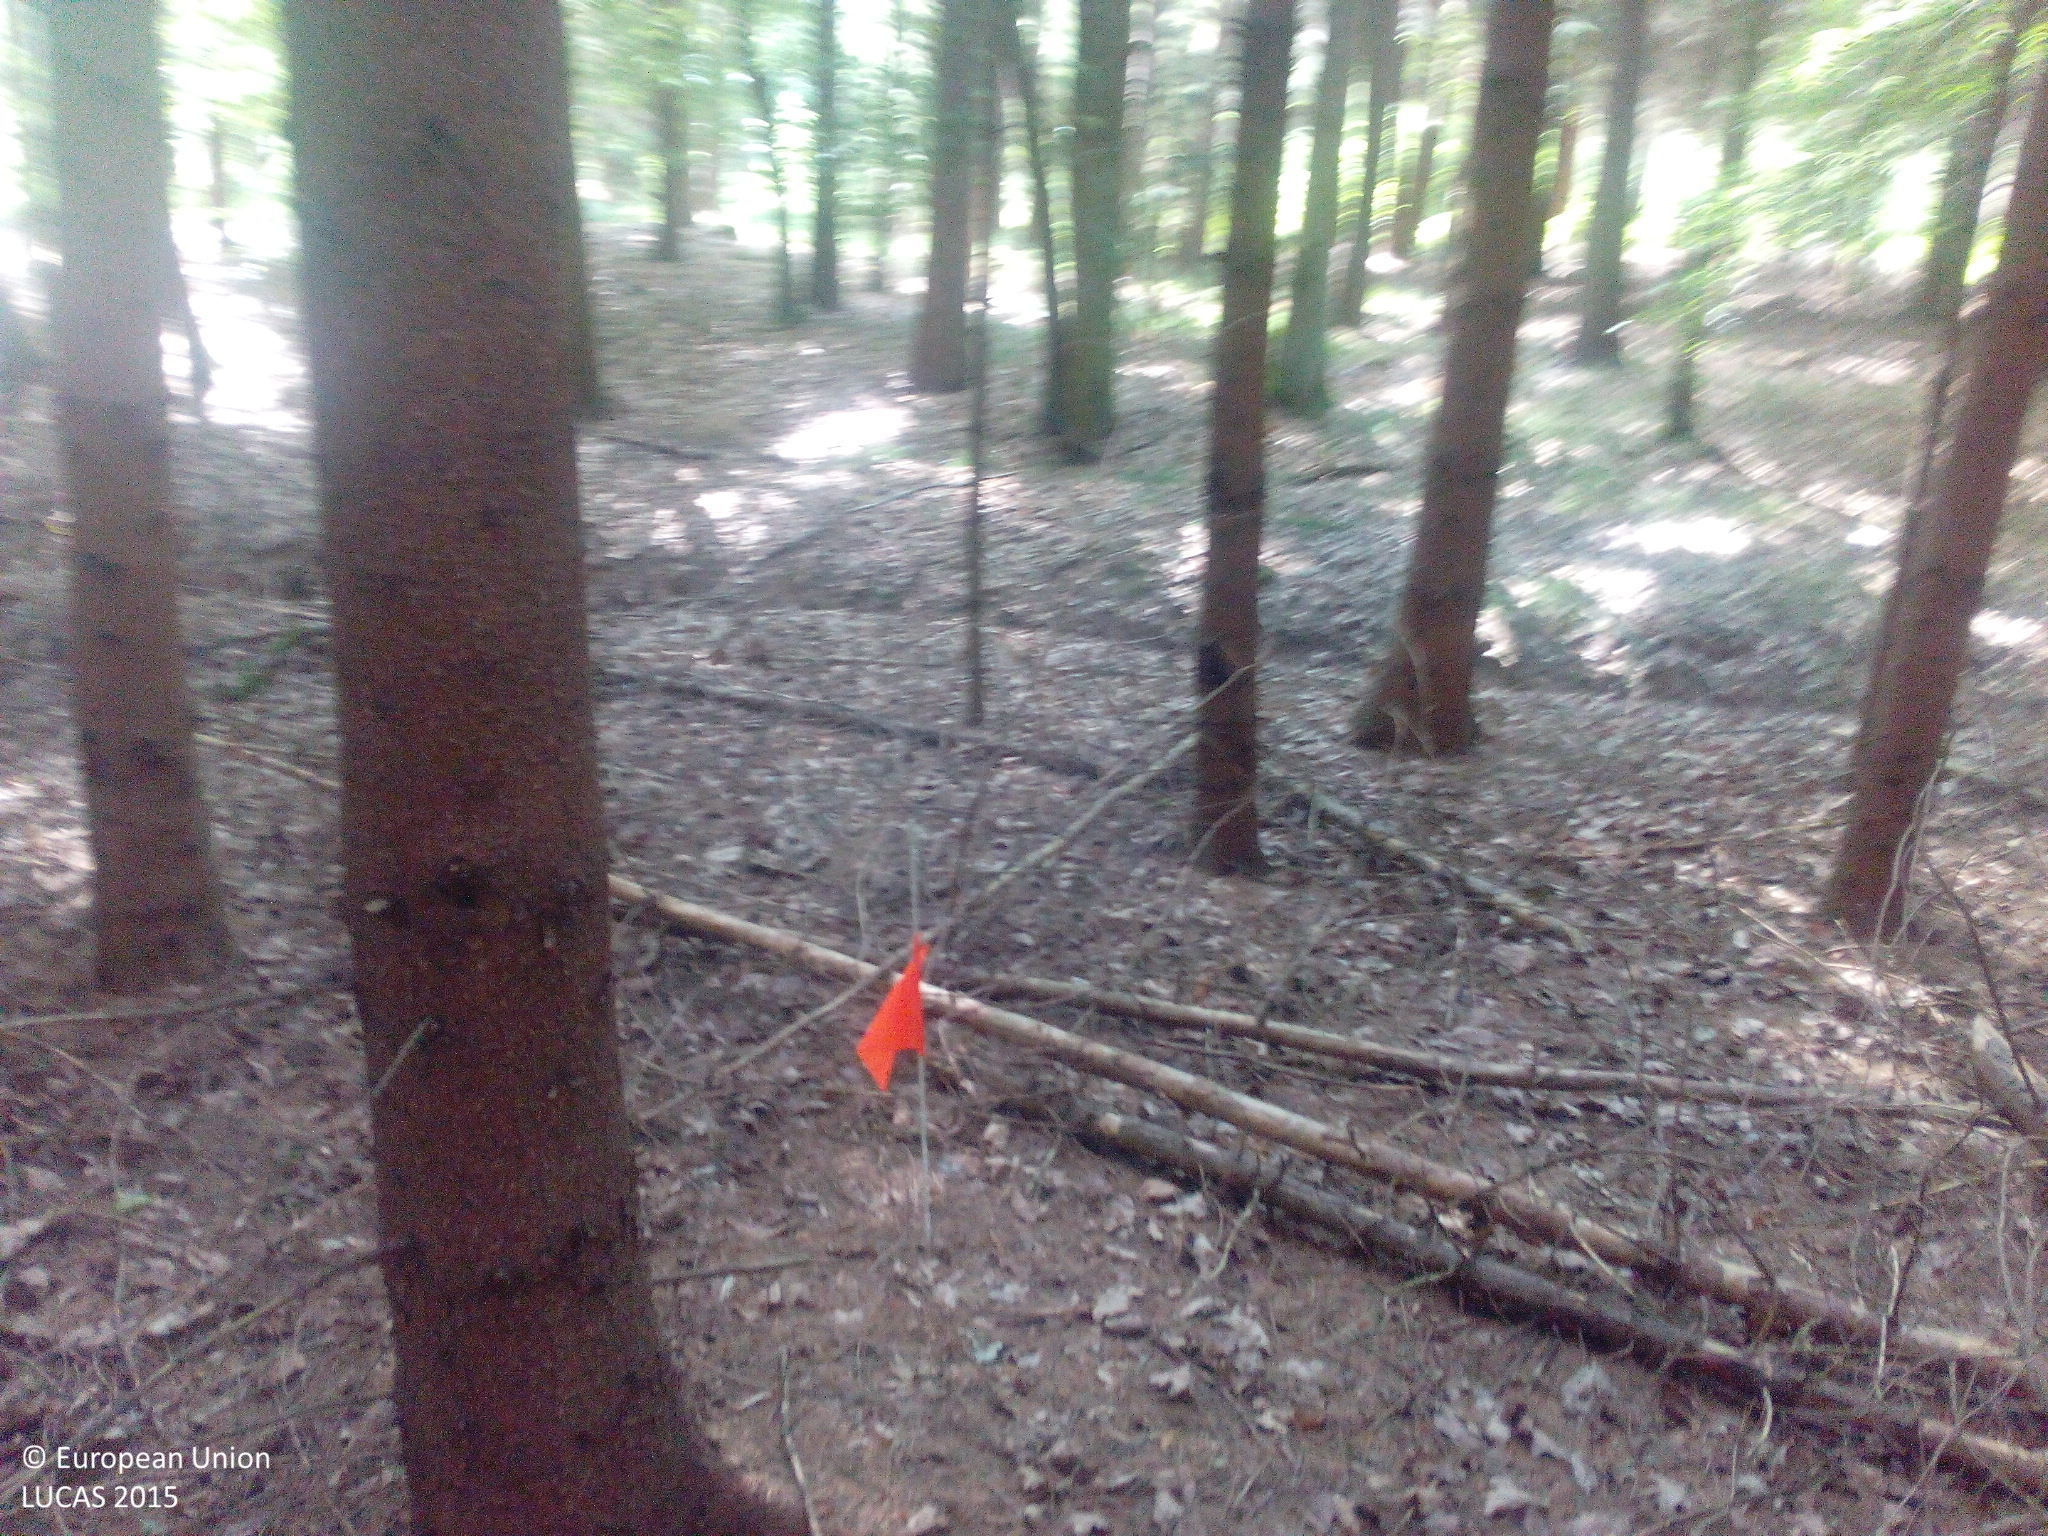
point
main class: Woodland
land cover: Spruce dominated coniferous woodland
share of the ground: > 75 %
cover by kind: coniferous forest trees 95 %, unconsolidated bare surface 5 %
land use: Forestry
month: July
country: DE
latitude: 49.7670
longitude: 10.9022
